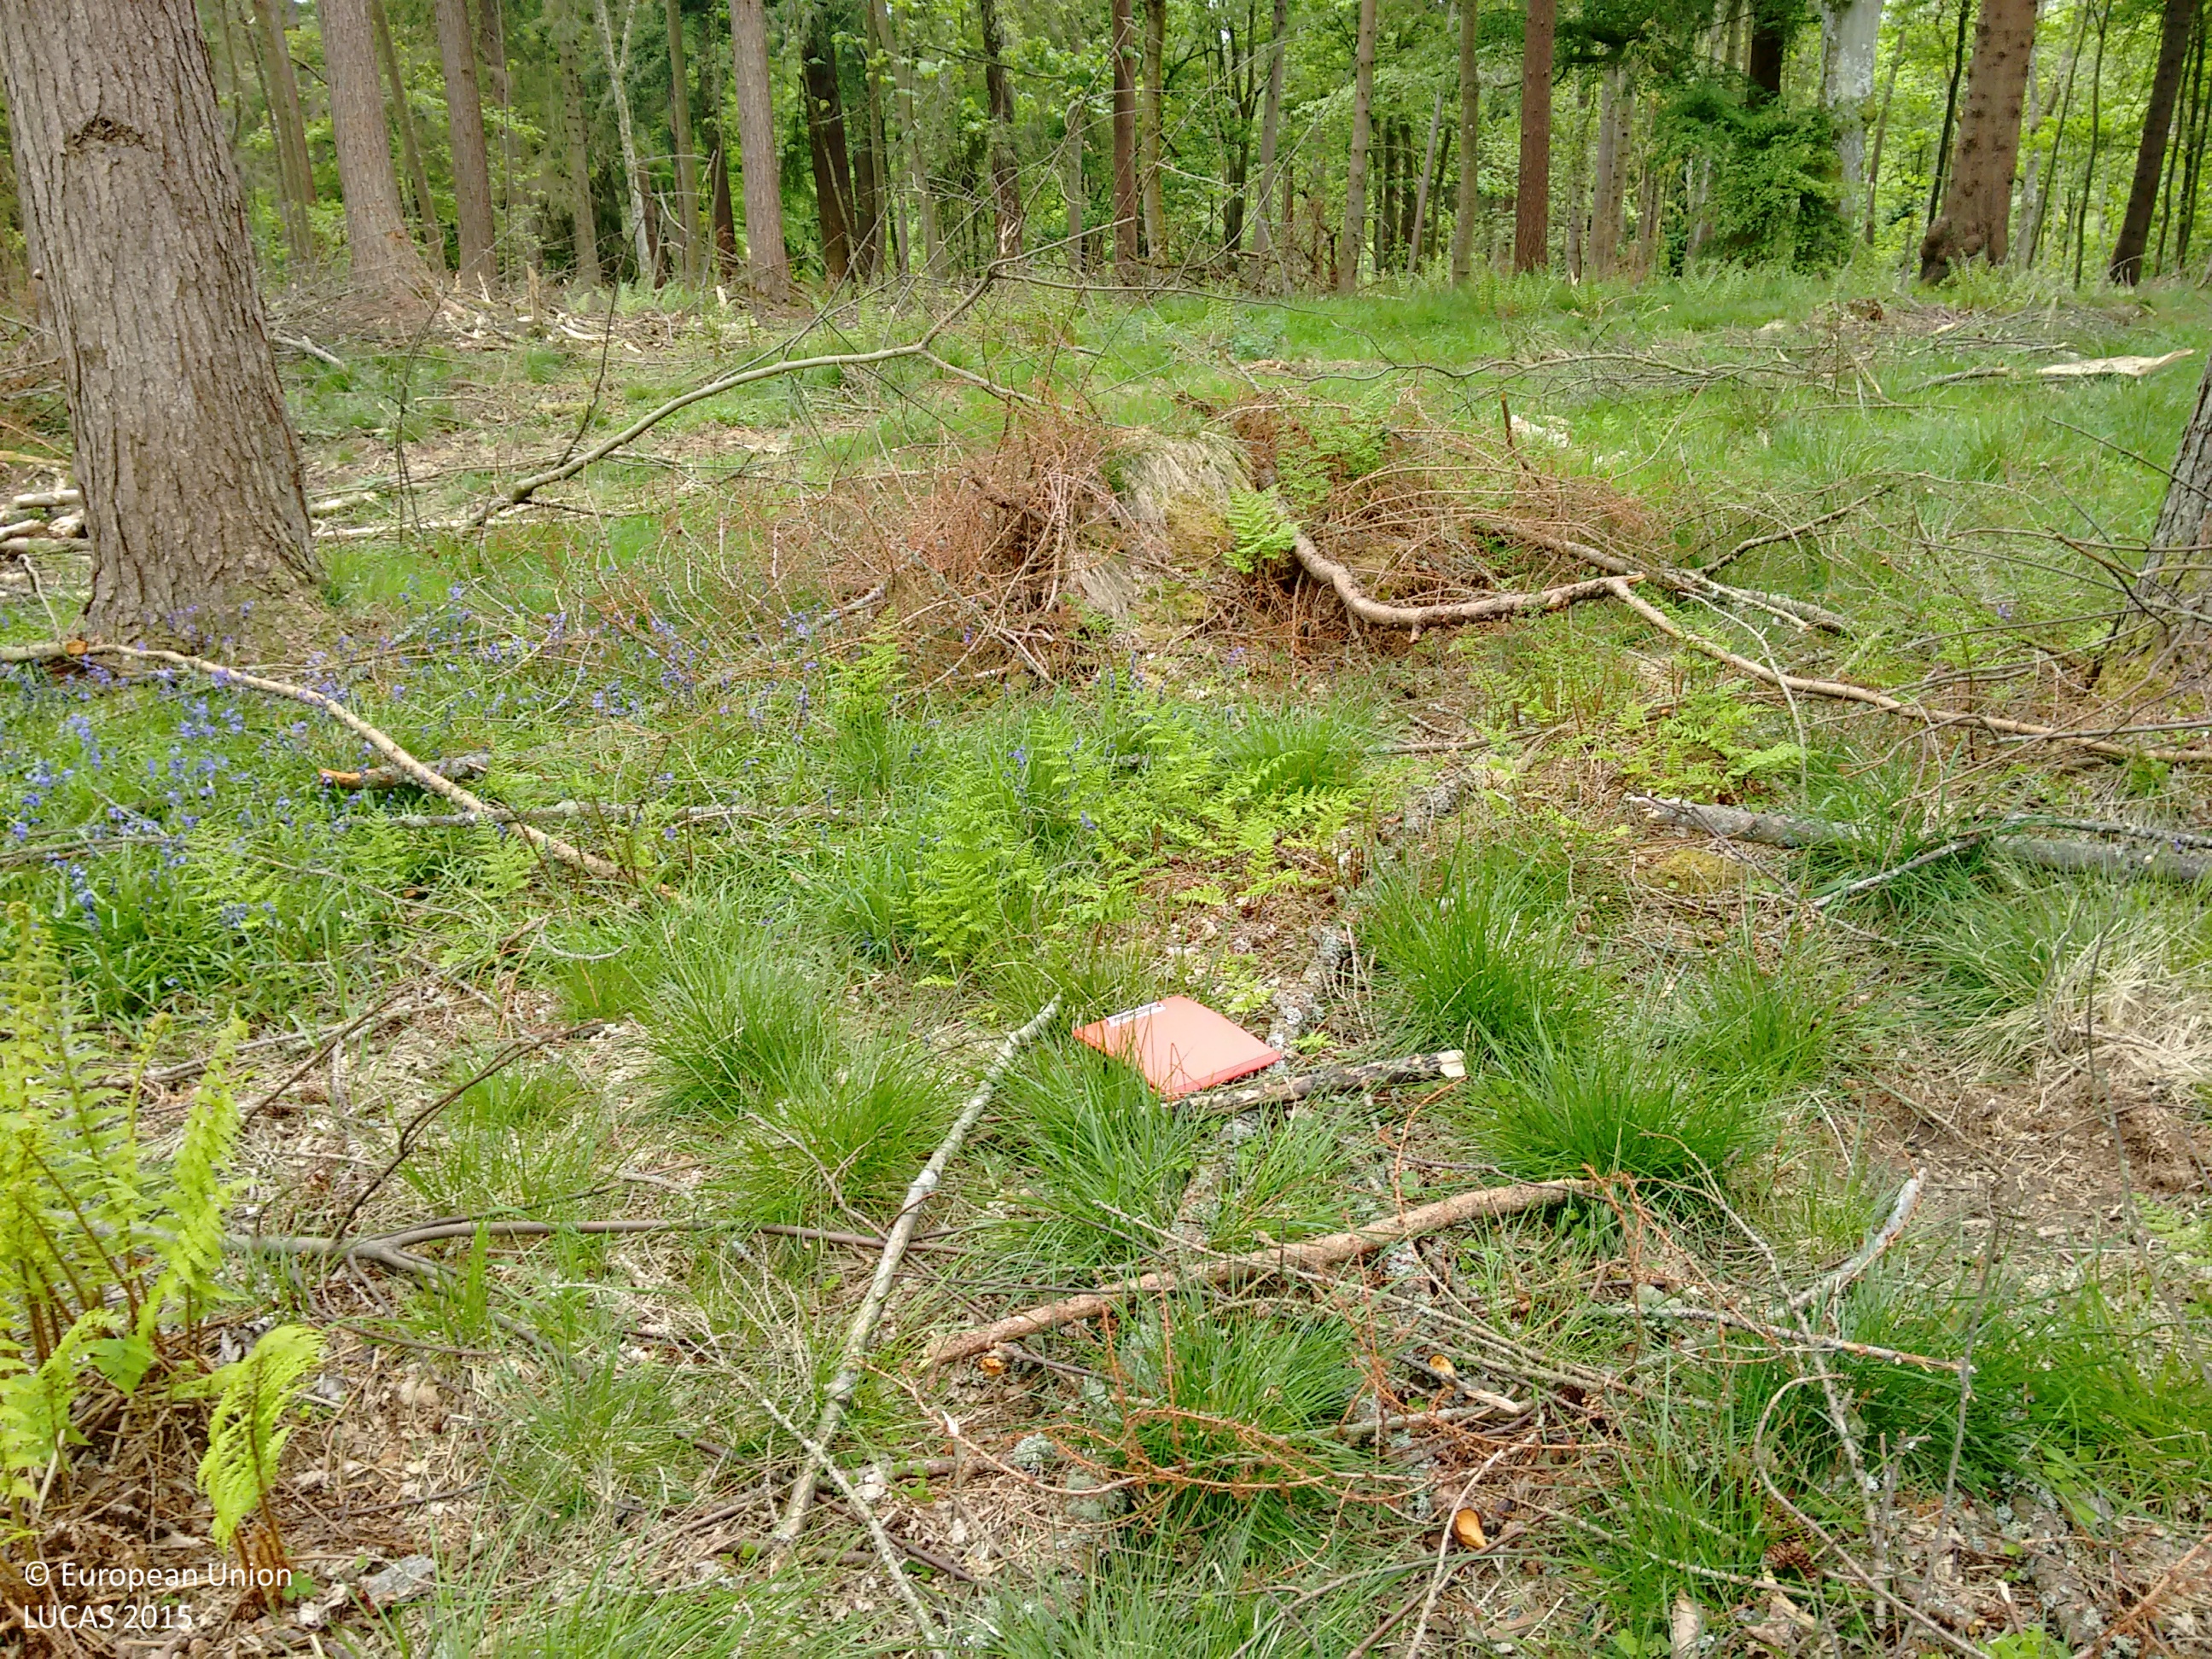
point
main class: Woodland
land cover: Other mixed woodland
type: hemiboreal forest and nemoral coniferous forest and mixed broadleaved-coniferous forest
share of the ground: > 75 %
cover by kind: broadleaved forest trees 50 %, coniferous forest trees 40 %, herbaceous plants 10 %
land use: Forestry
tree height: > 5 m
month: May
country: GB
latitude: 56.3267
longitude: -3.5147
